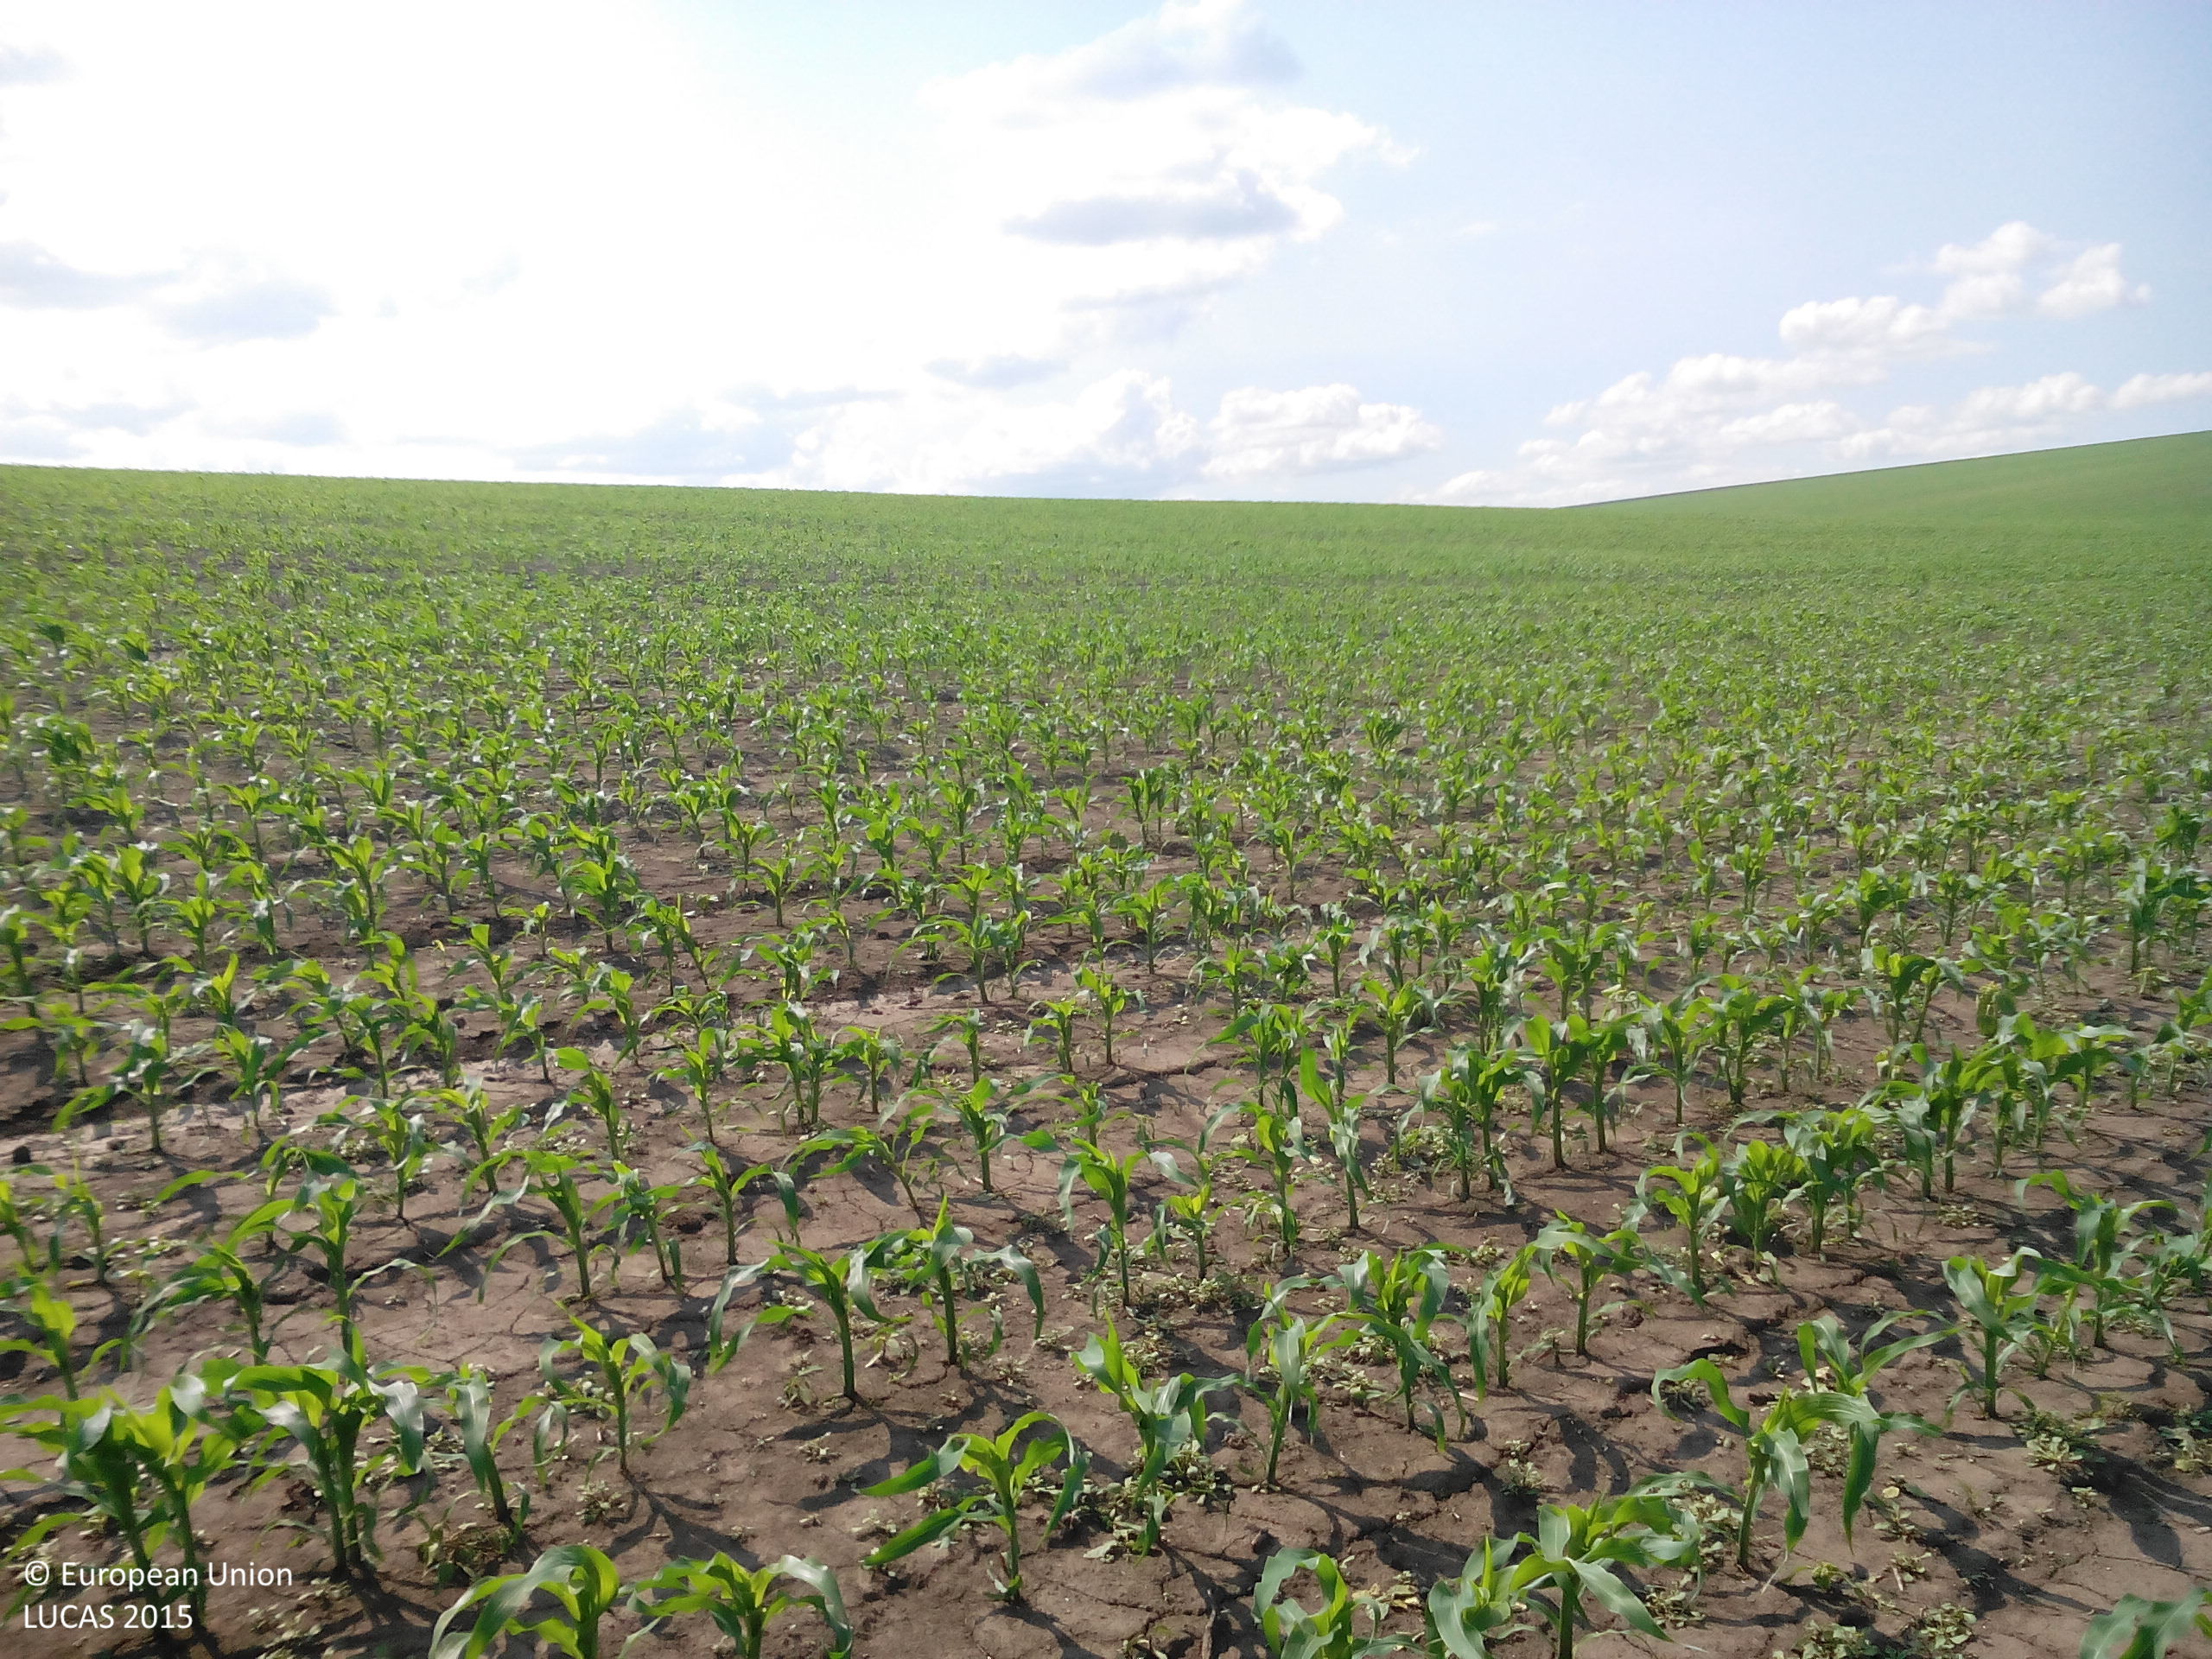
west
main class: Cropland
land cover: Maize
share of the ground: 25 - 50 %
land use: Agriculture (excluding fallow land and kitchen gardens)
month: May
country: BG
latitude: 43.5927
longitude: 24.1647
